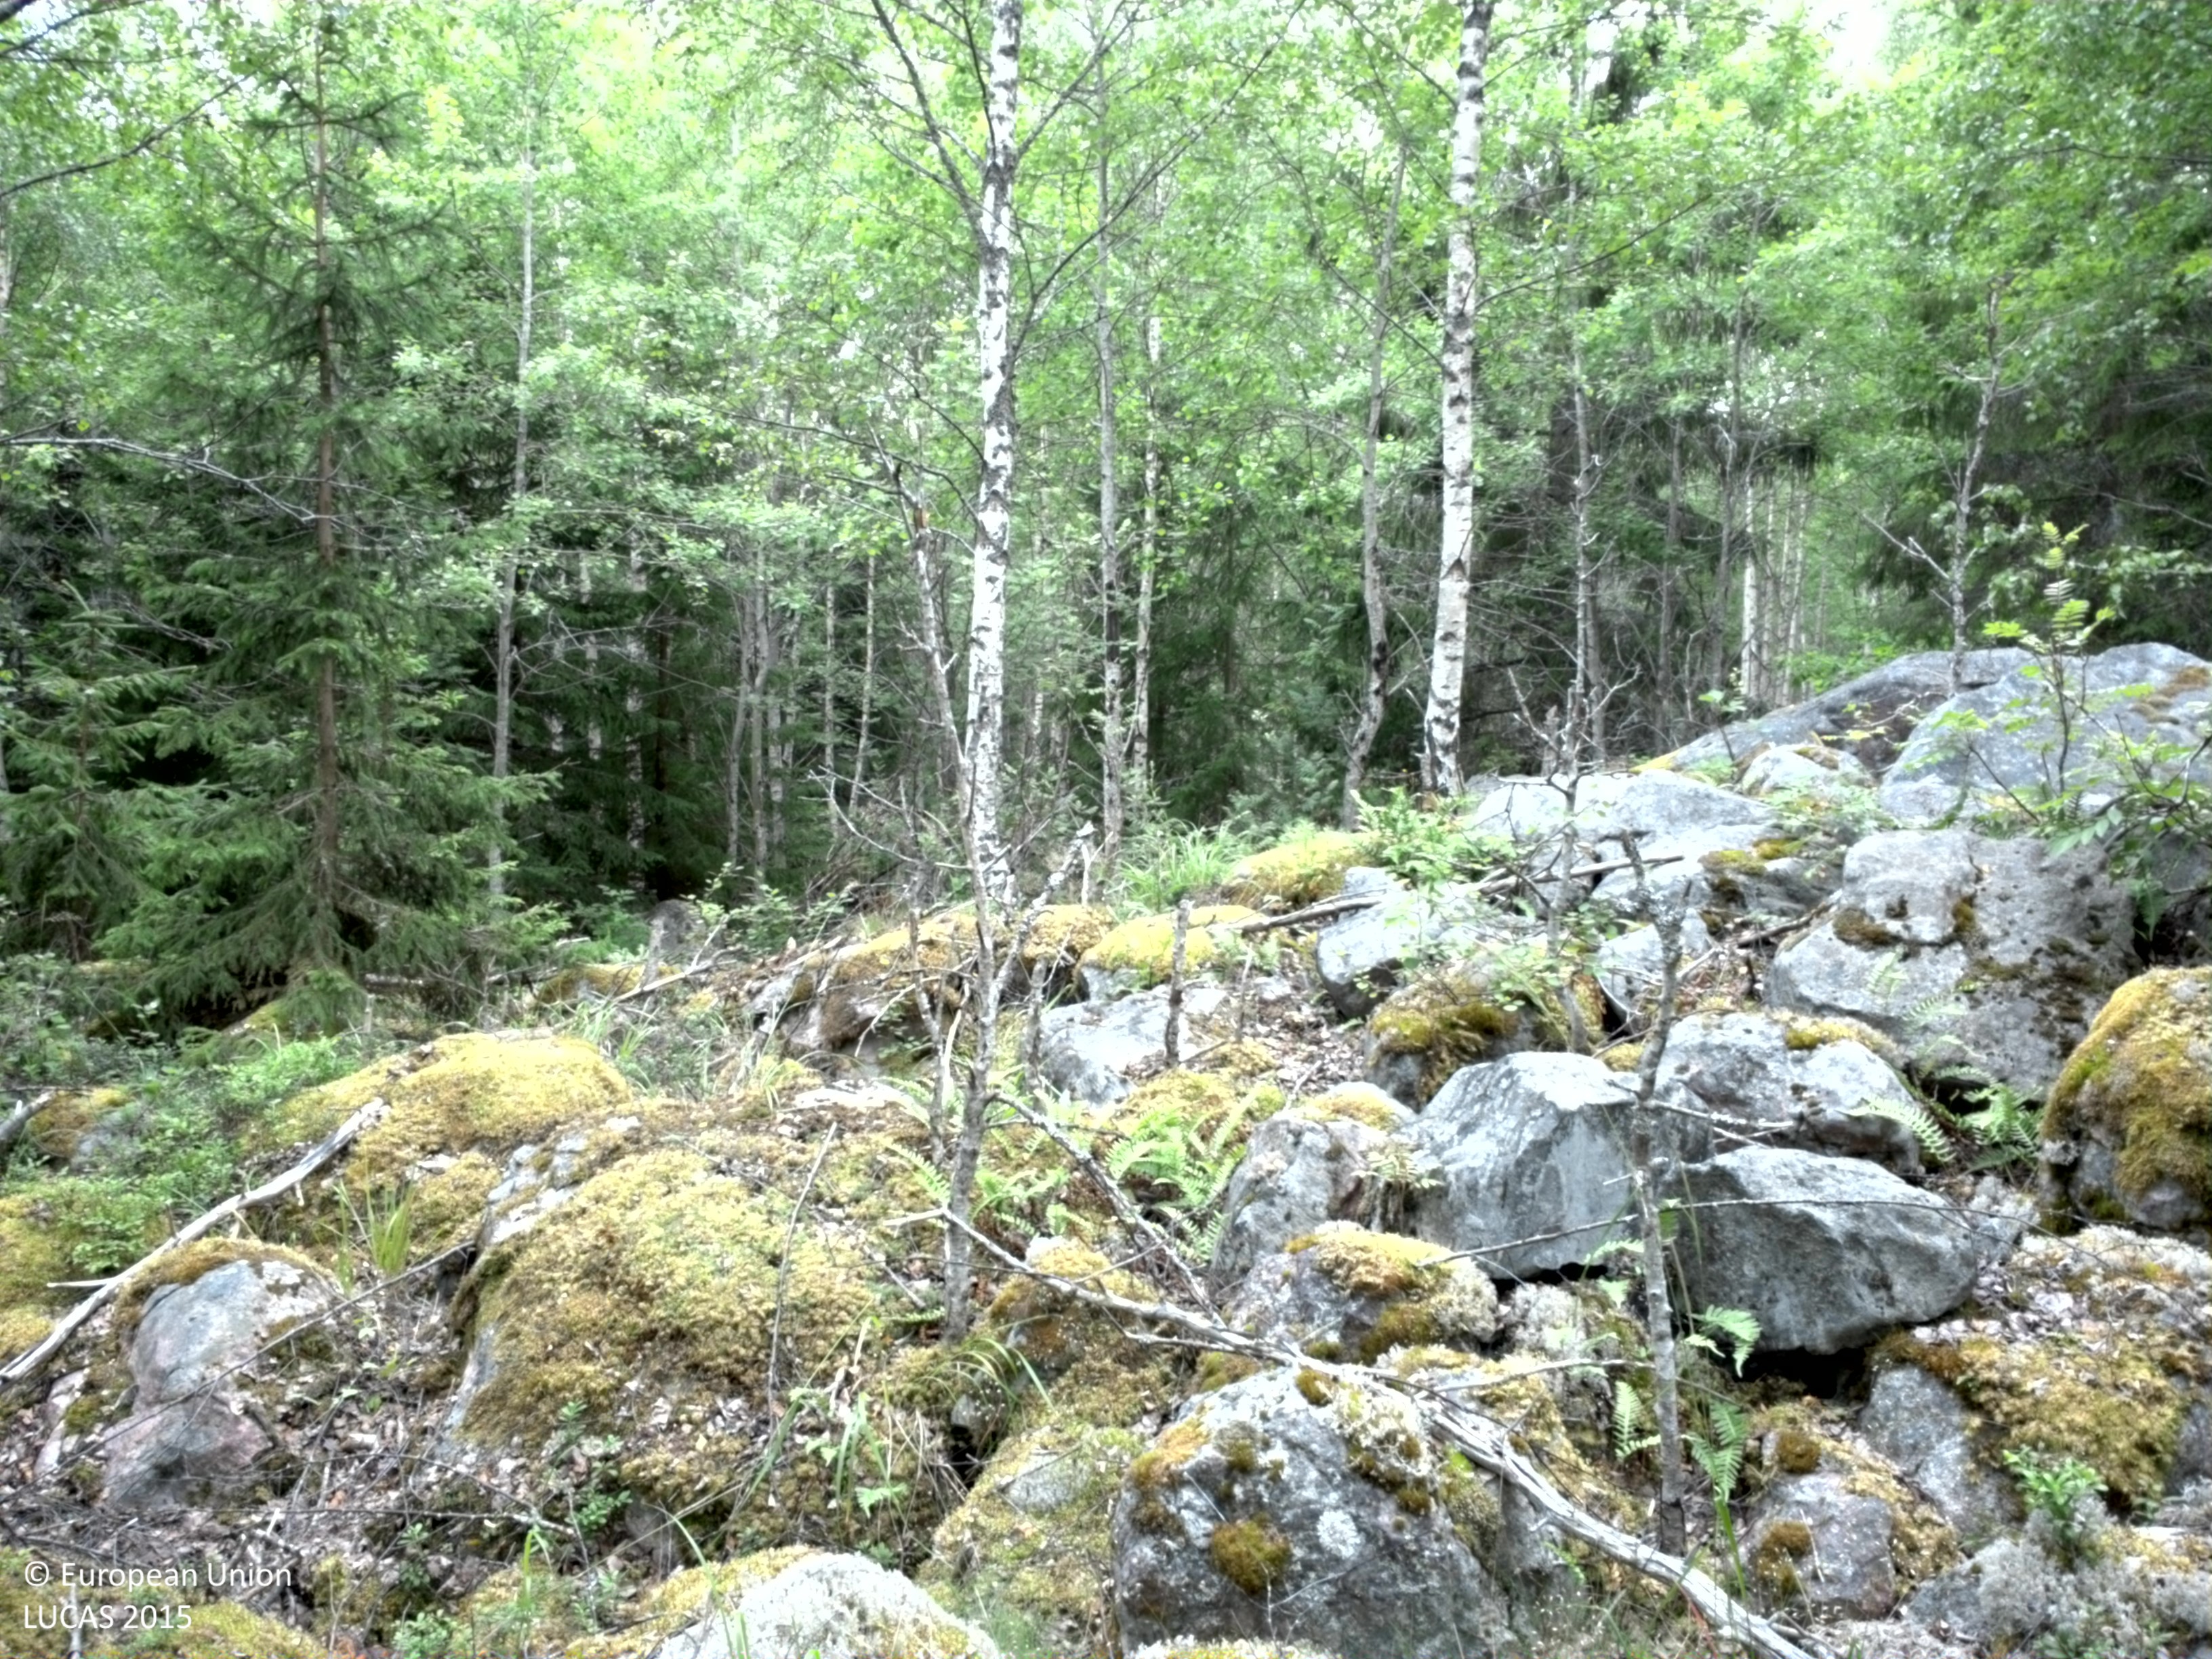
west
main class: Woodland
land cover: Spruce dominated mixed woodland
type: boreal forest
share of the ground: 50 - 75 %
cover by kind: coniferous forest trees 45 %, lichens and mosses 20 %, broadleaved forest trees 15 %, herbaceous plants 10 %, consolidated bare surface 10 %
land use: Forestry
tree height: > 5 m
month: July
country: SE
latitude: 59.7971
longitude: 18.4993
